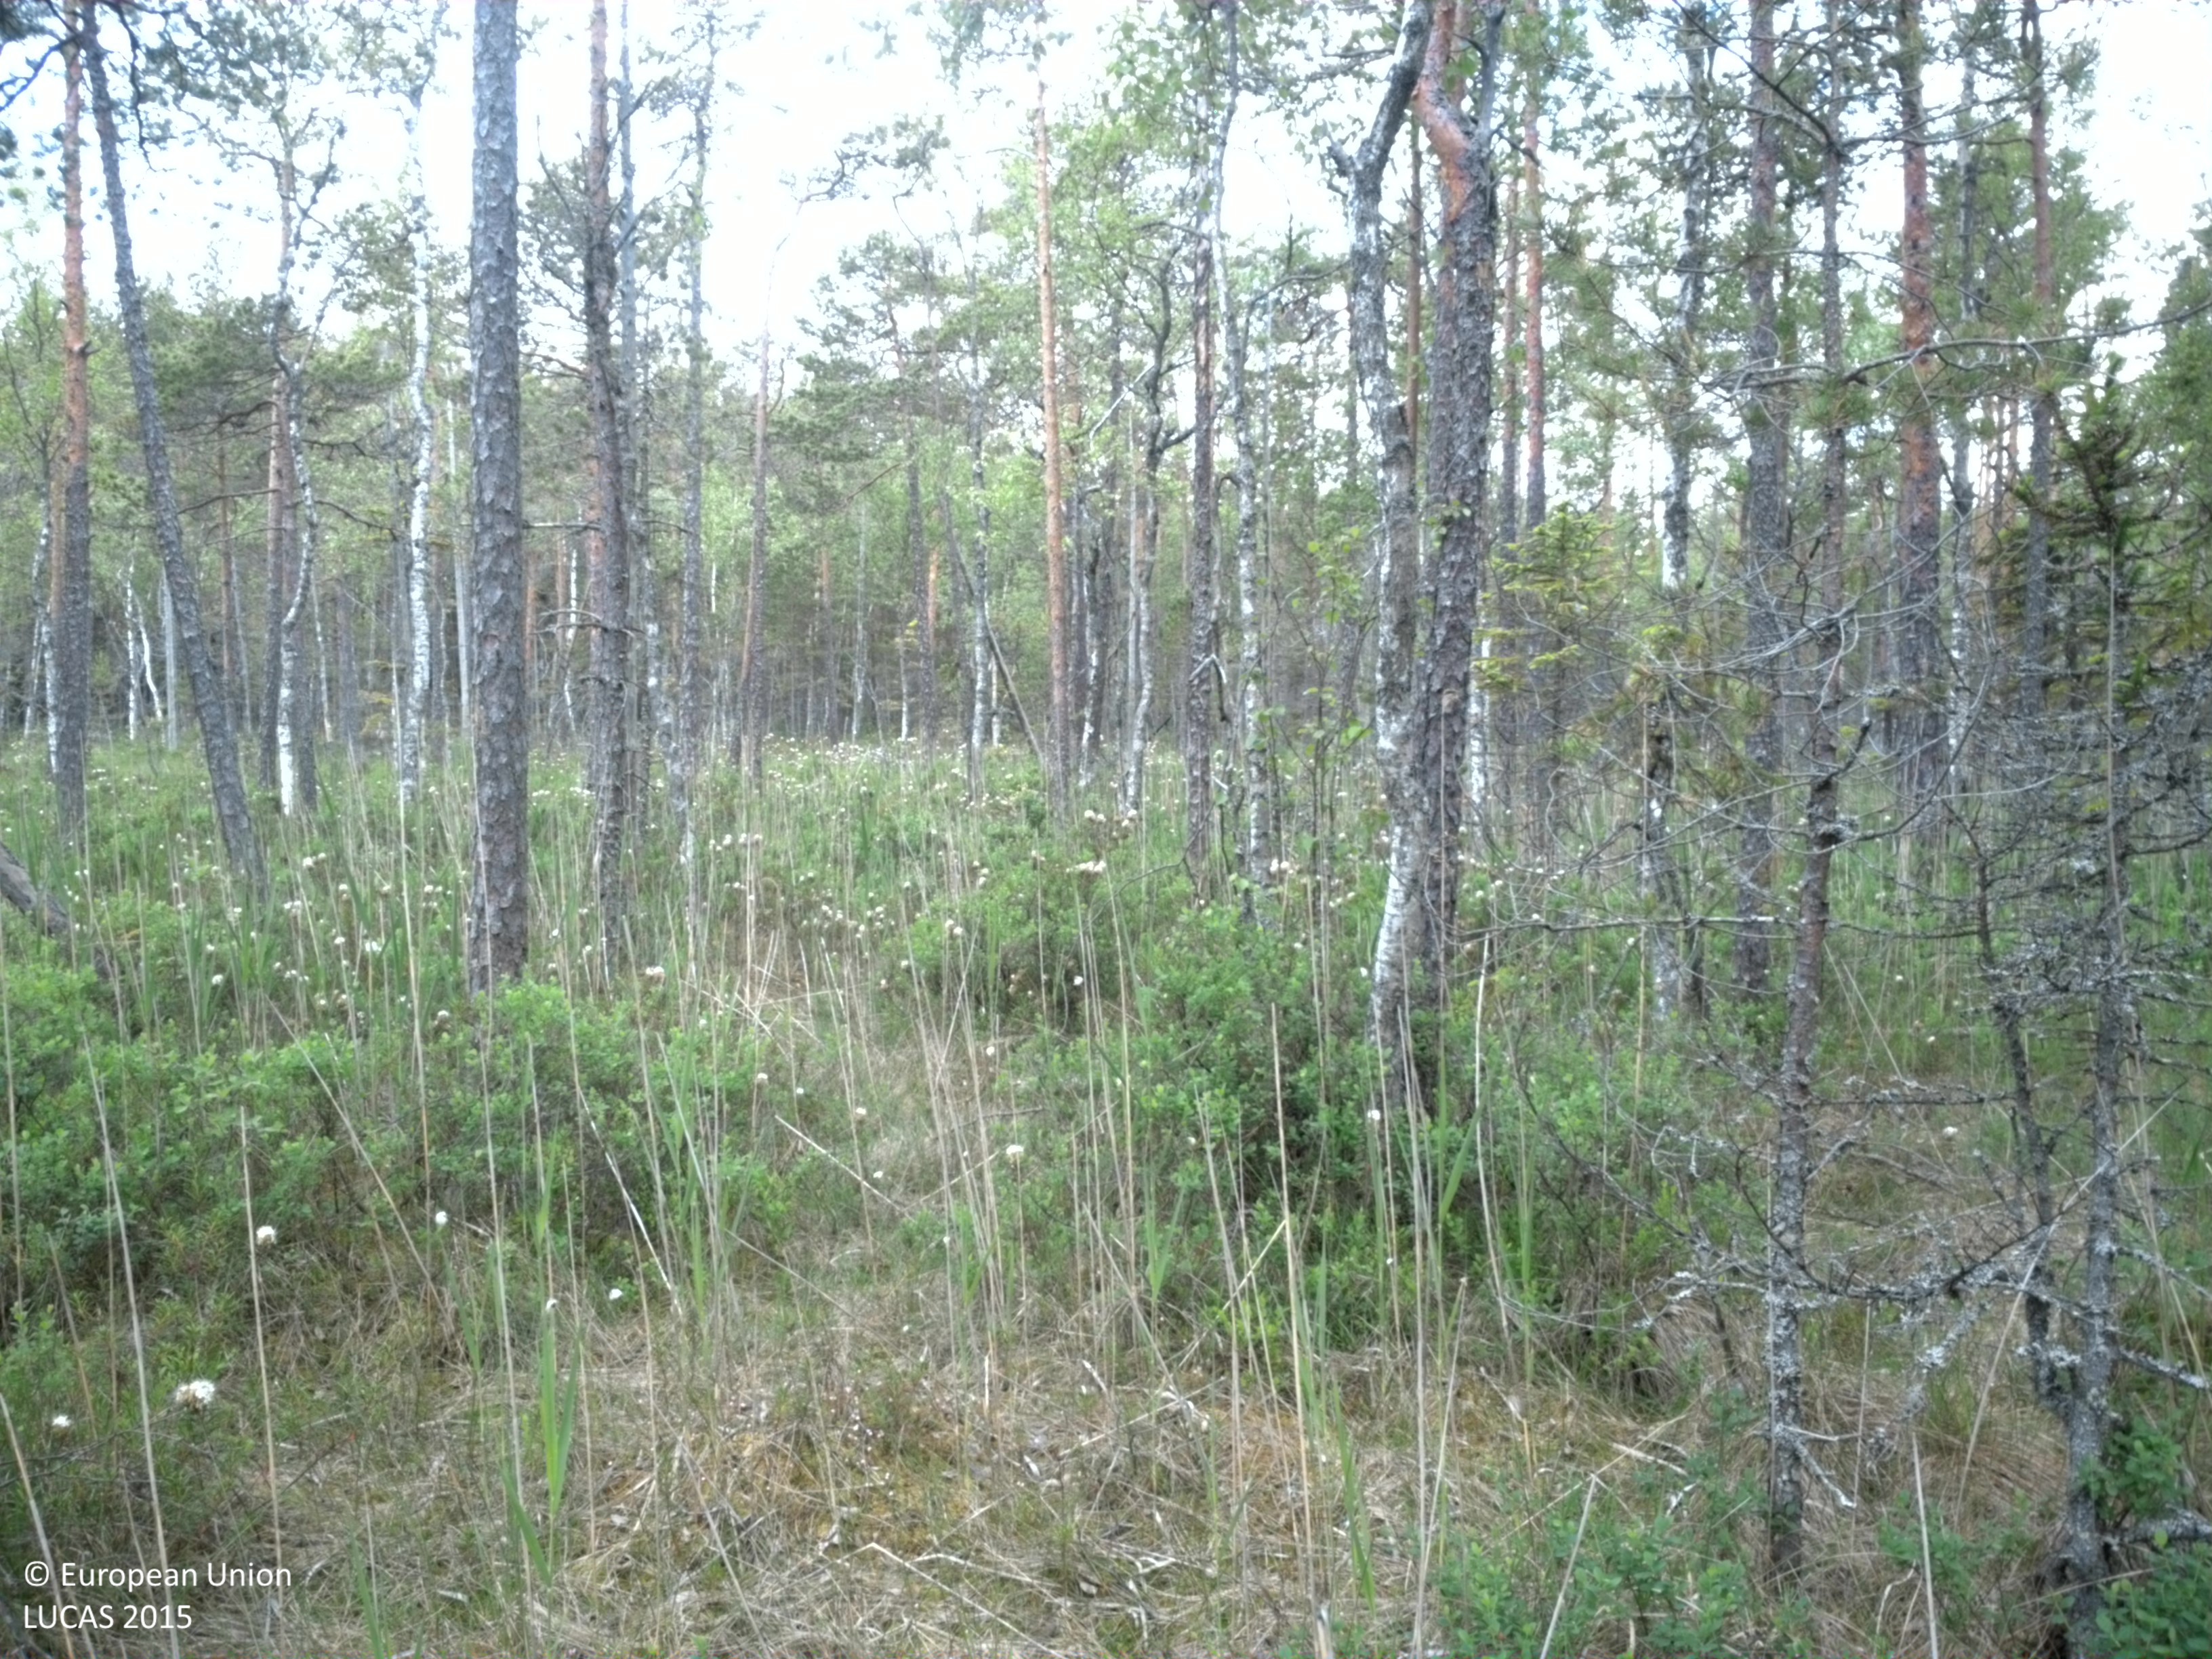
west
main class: Woodland
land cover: Pine dominated coniferous woodland
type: boreal forest
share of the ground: 25 - 50 %
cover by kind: coniferous forest trees 45 %, herbaceous plants 25 %, lichens and mosses 25 %, broadleaved forest trees 5 %
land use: Forestry
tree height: > 5 m
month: June
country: SE
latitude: 59.9458
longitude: 17.1348
